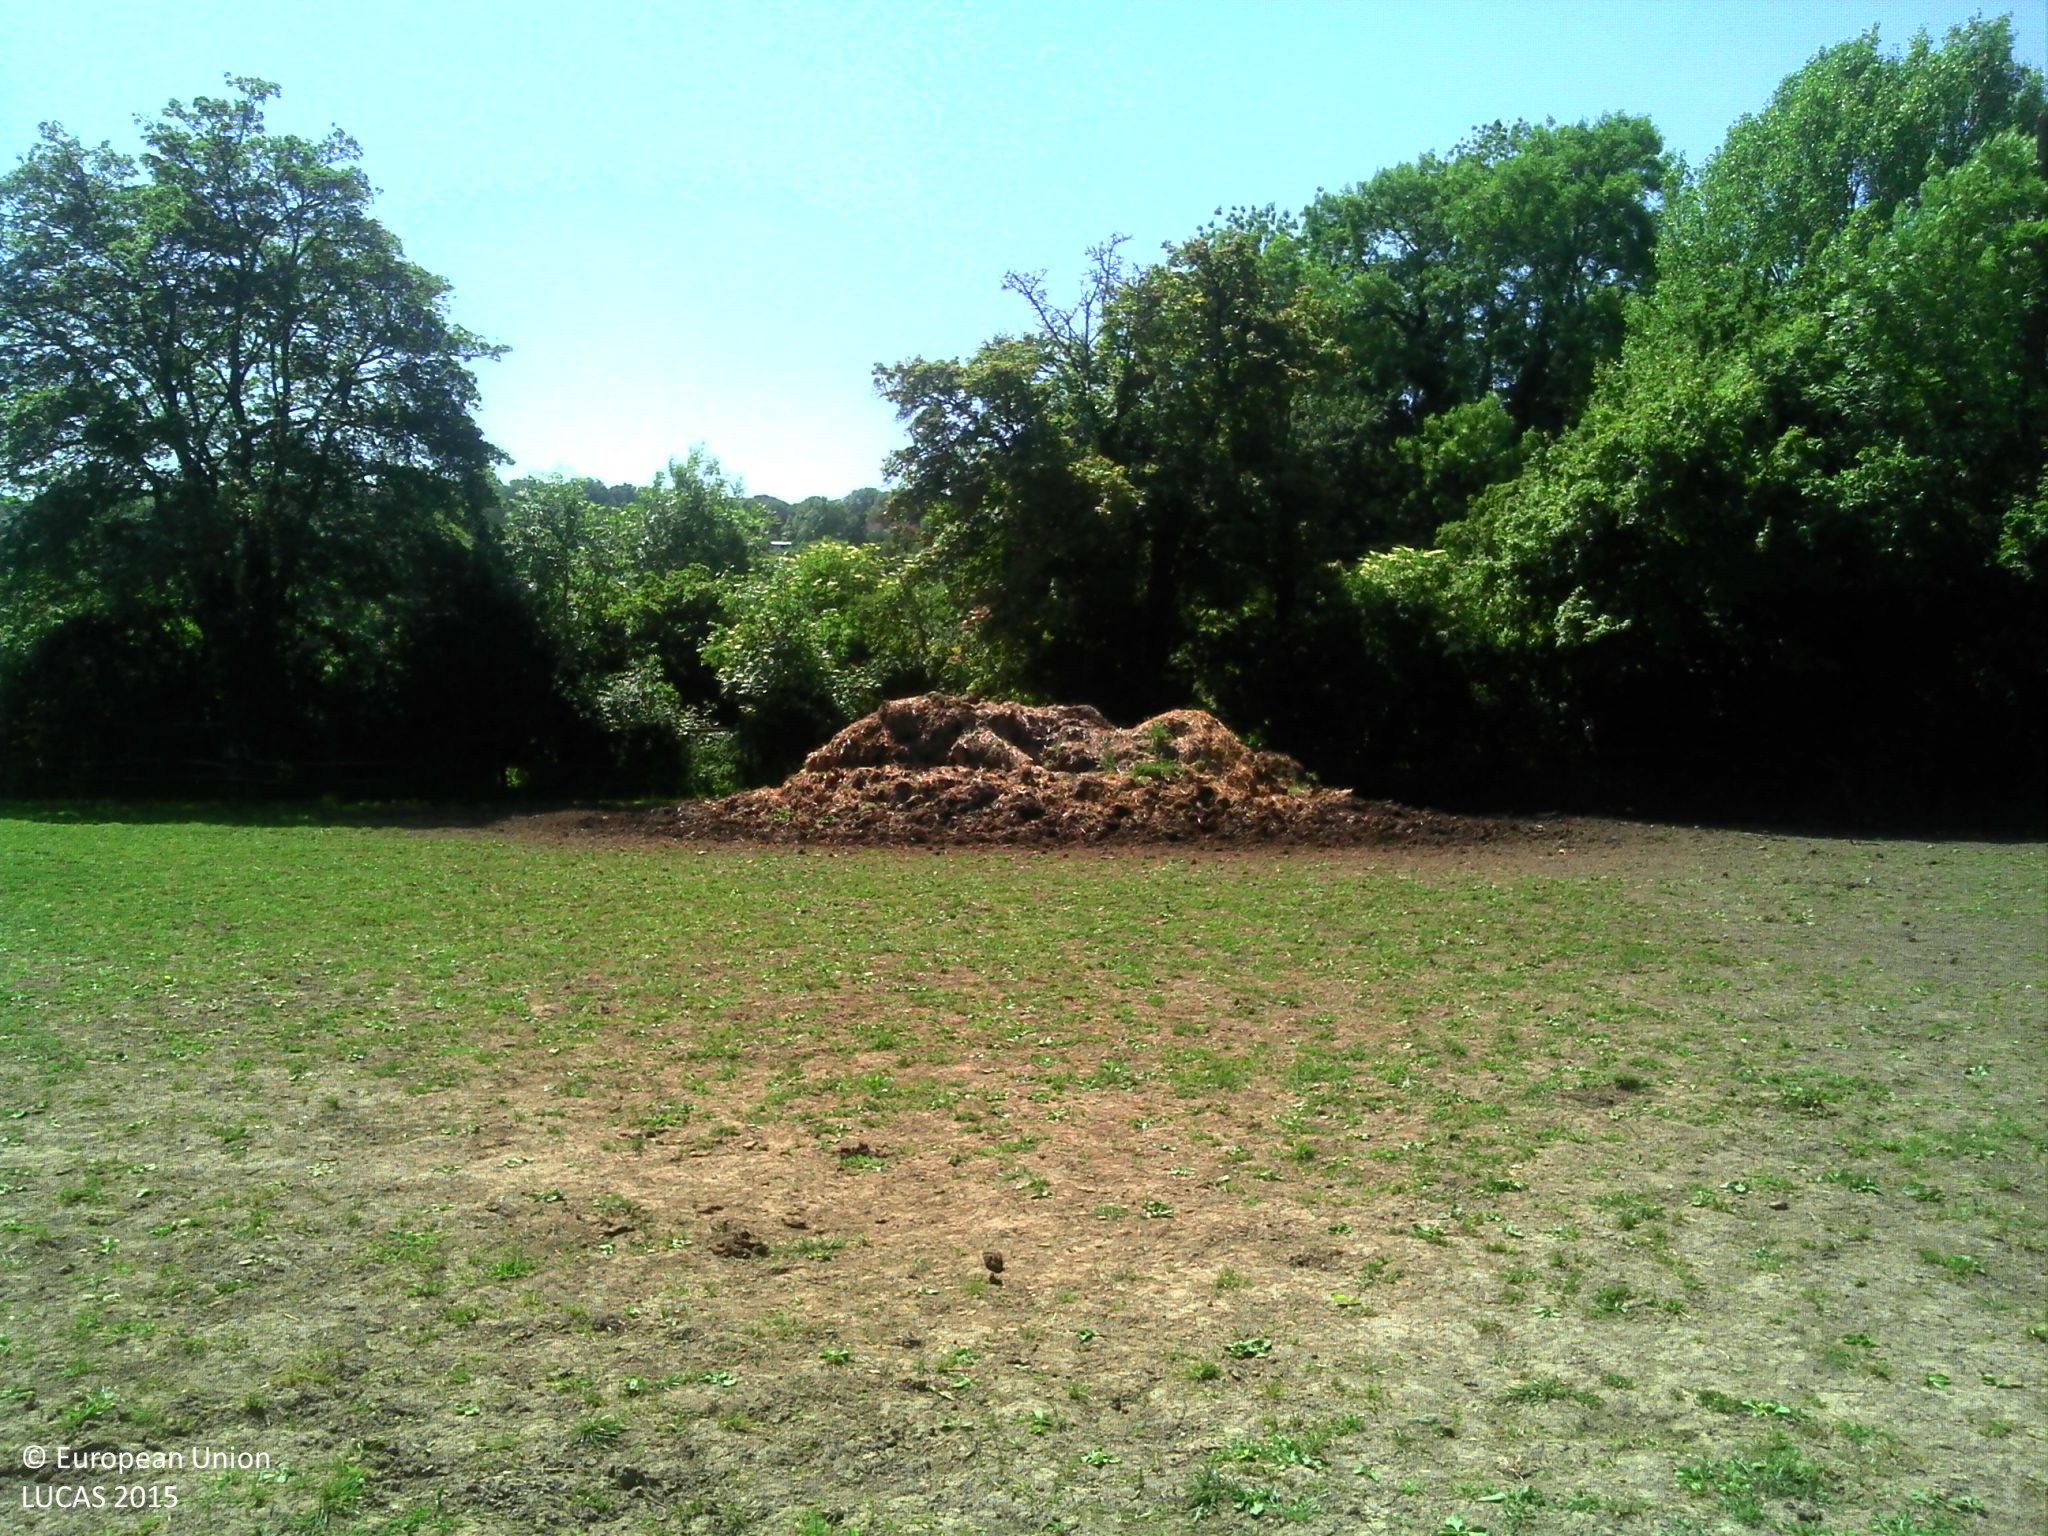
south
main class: Grassland
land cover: Grassland without tree/shrub cover
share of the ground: 50 - 75 %
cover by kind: herbaceous plants 85 %, unconsolidated bare surface 15 %
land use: Agriculture (excluding fallow land and kitchen gardens)
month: June
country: FR
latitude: 48.7589
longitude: 0.1360
